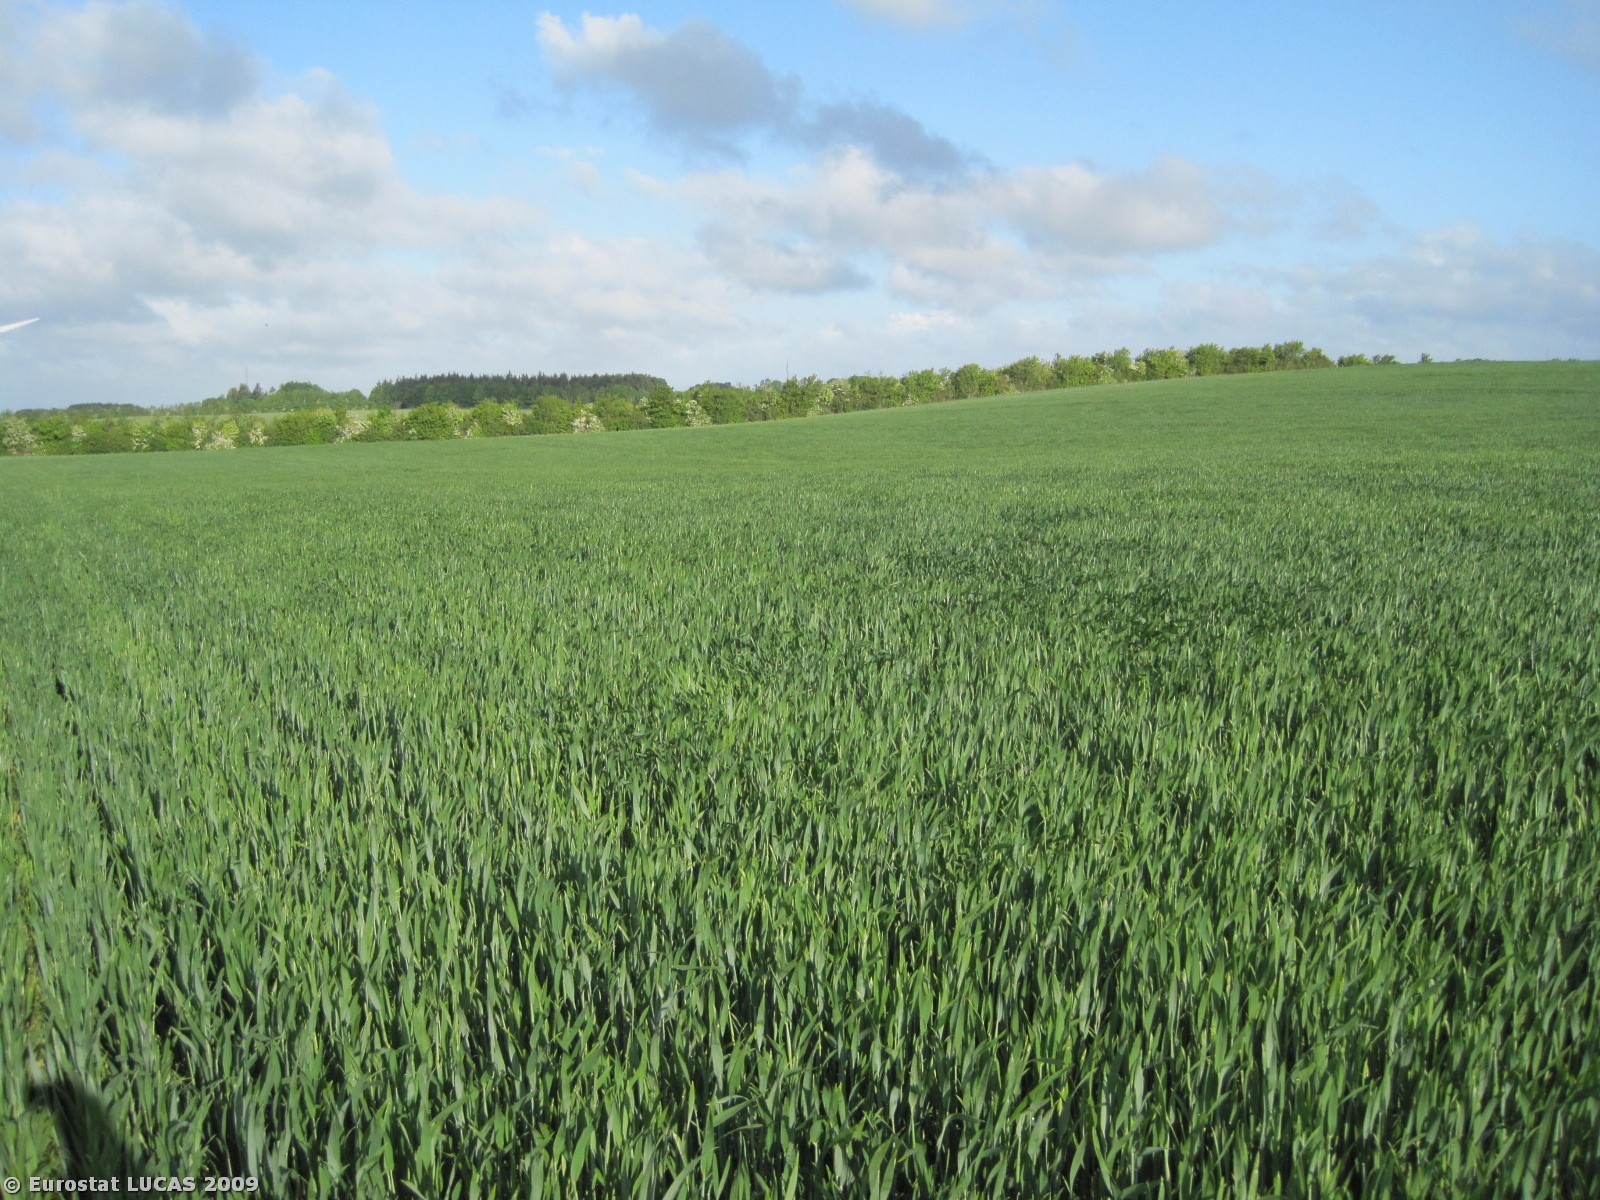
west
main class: Cropland
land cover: Common wheat
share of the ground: > 75 %
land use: Agriculture (excluding fallow land and kitchen gardens)
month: May
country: DK
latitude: 56.5472
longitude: 10.0812
